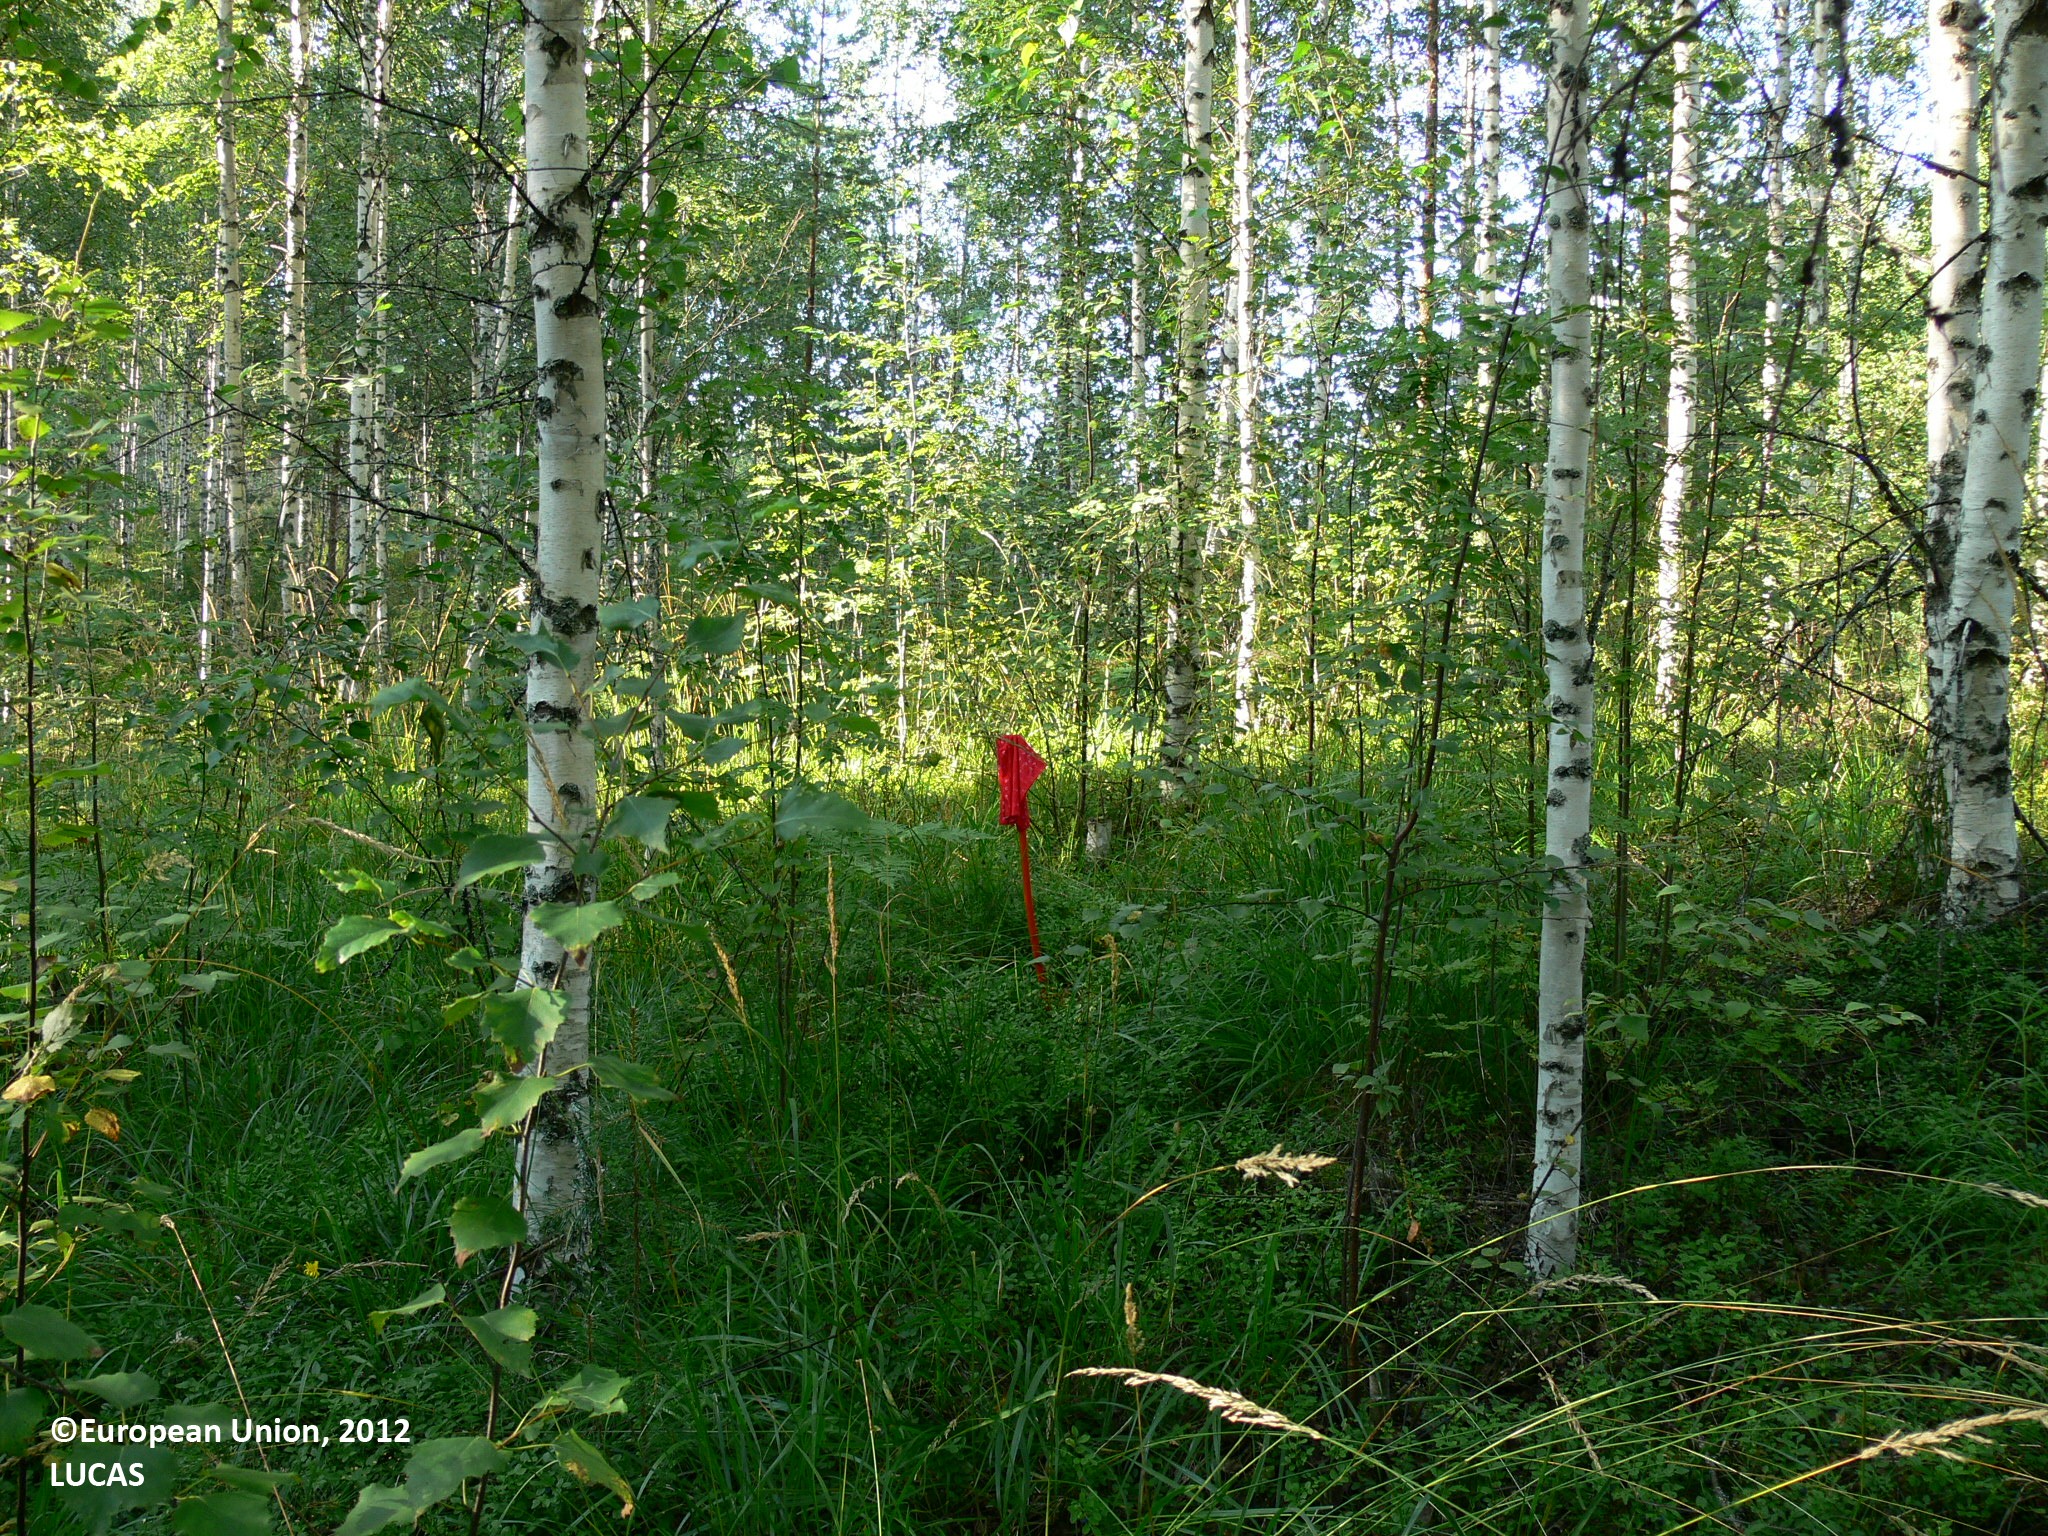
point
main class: Woodland
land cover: Broadleaved woodland
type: boreal forest
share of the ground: > 75 %
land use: Forestry
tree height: > 5 m
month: August
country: FI
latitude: 61.8715
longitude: 29.9446
